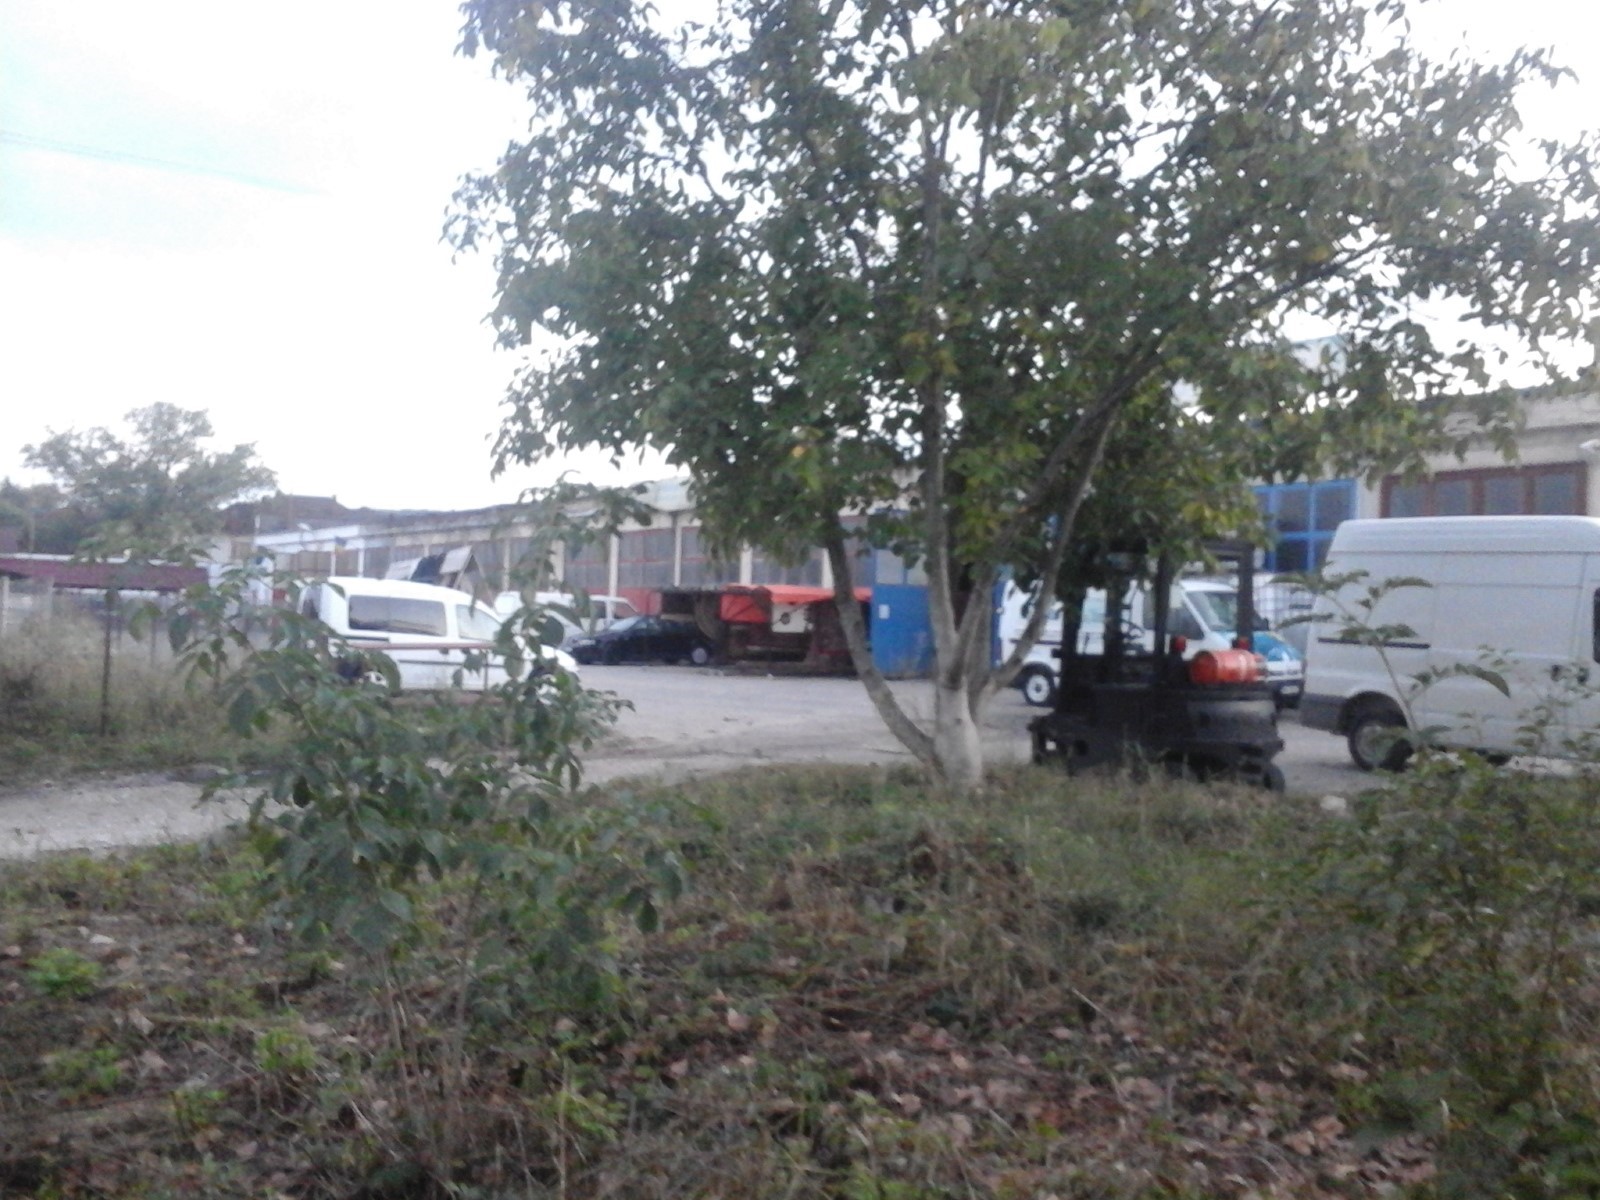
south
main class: Cropland
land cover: Other fruit trees and berries
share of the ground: > 75 %
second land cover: Grassland without tree/shrub cover
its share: > 75 %
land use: Agriculture (excluding fallow land and kitchen gardens)
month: September
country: RO
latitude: 47.5018
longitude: 23.4684
